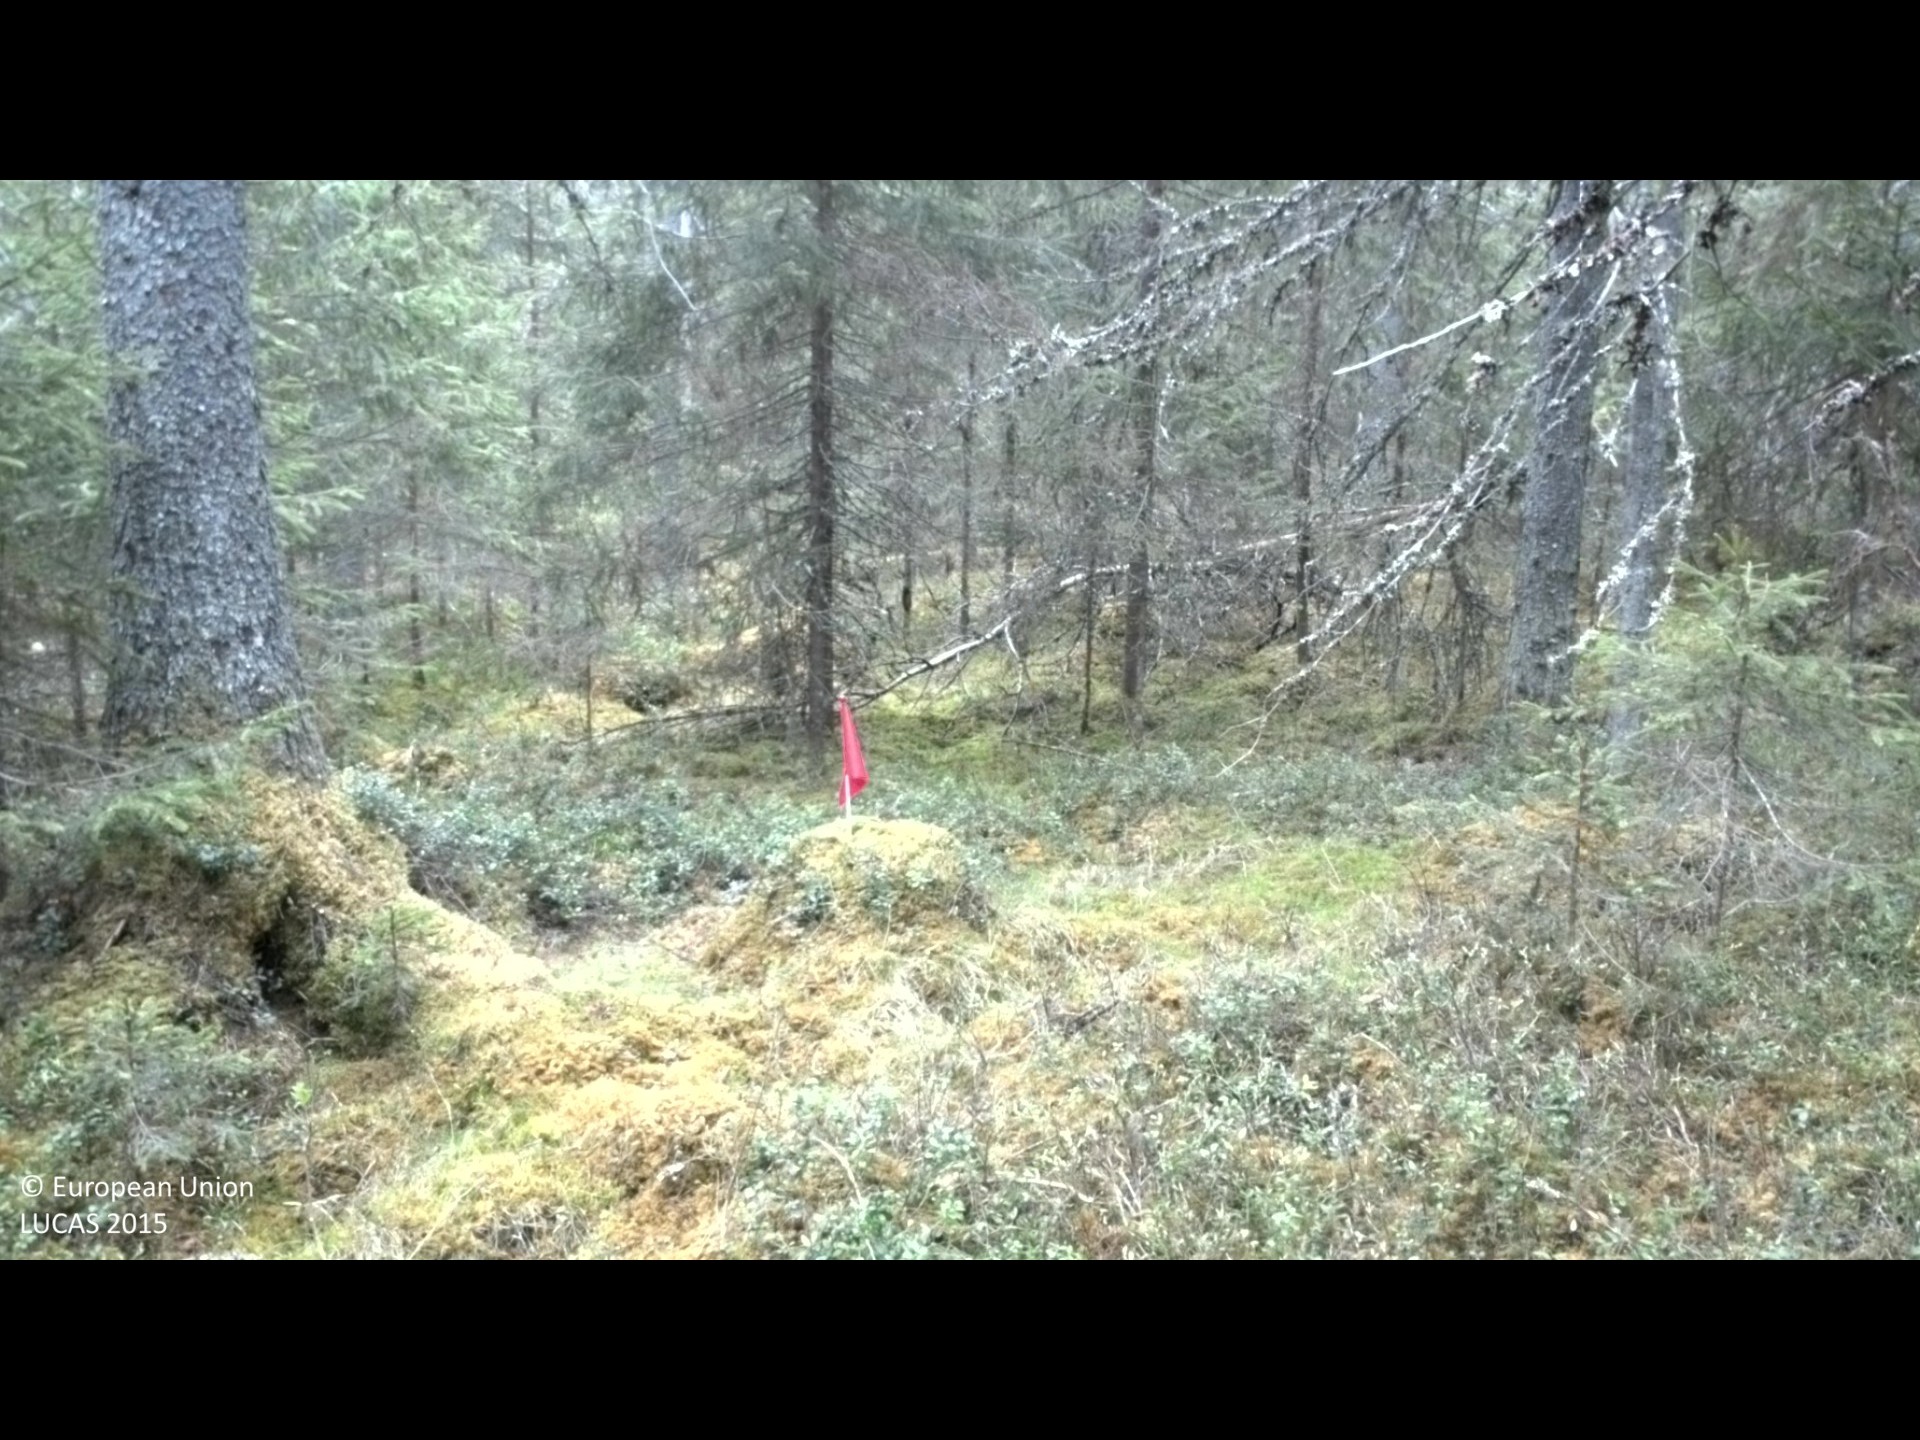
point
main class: Woodland
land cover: Spruce dominated coniferous woodland
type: boreal forest
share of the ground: 50 - 75 %
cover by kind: coniferous forest trees 75 %, shrubs 15 %, lichens and mosses 10 %
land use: Forestry
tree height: > 5 m
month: May
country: SE
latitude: 63.1205
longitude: 17.3711
